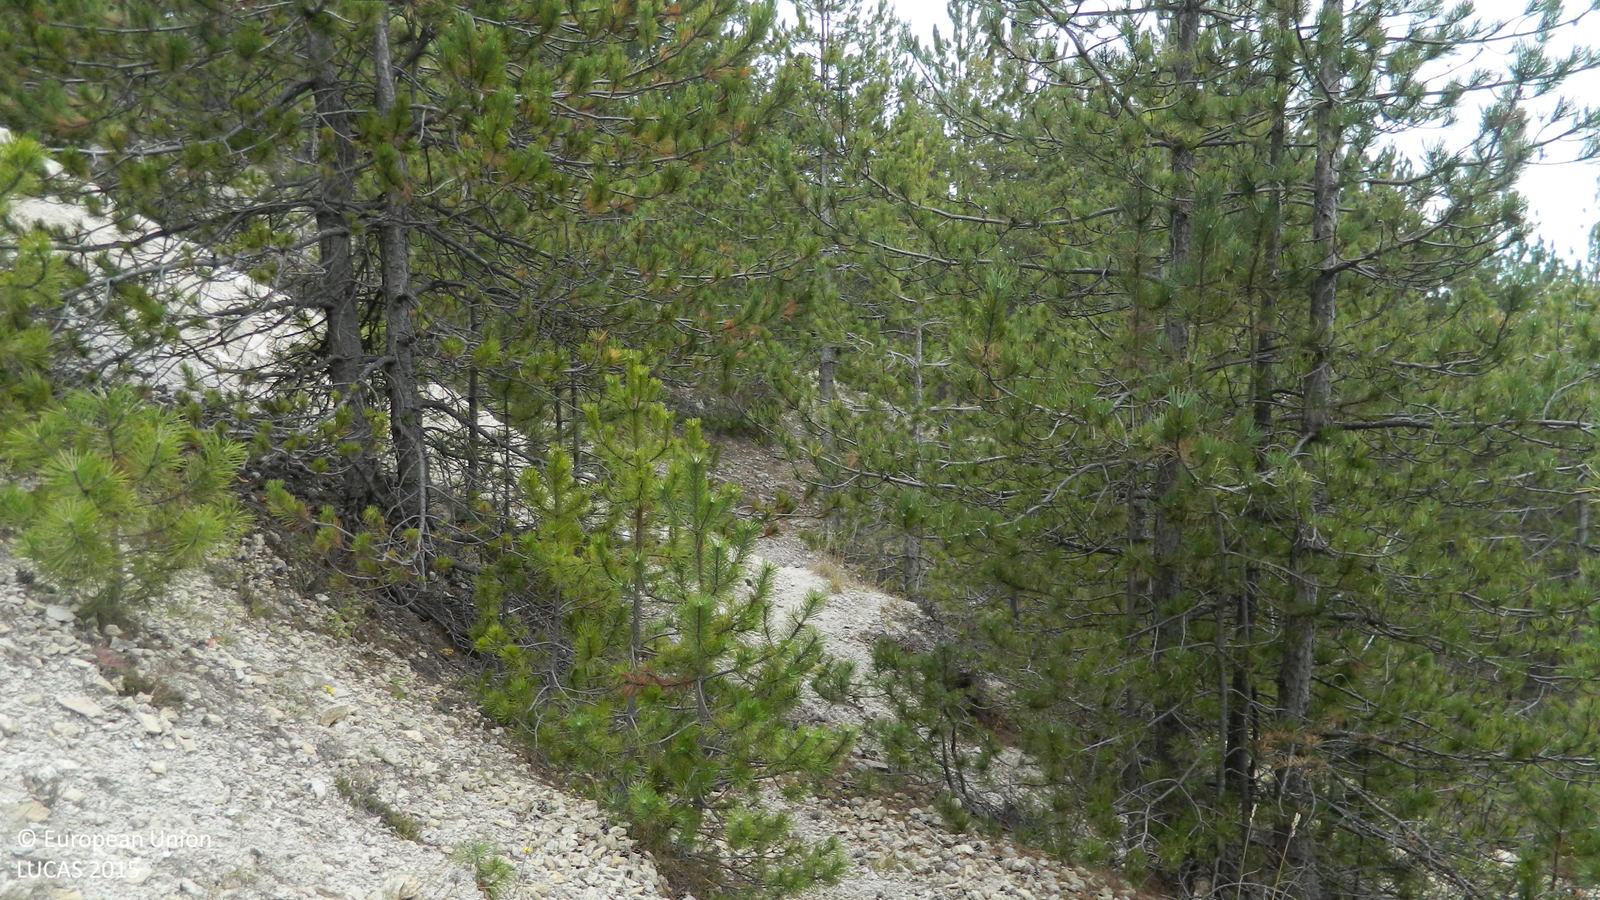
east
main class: Woodland
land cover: Pine dominated coniferous woodland
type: alpine coniferous forest
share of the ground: 50 - 75 %
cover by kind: coniferous forest trees 70 %, unconsolidated bare surface 30 %
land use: Forestry
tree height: > 5 m
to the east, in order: Pine dominated coniferous woodland; Rocks and stones; Pine dominated coniferous woodland; Grassland without tree/shrub cover; Electric lines; Grassland without tree/shrub cover; Artificial constructions in urban areas; Broadleaved woodland; Shrubland with sparse tree cover; Electric lines; Shrubland with sparse tree cover; Broadleaved woodland; Tracks; Electric lines; Shrubland with sparse tree cover; Electric lines; Shrubland with sparse tree cover; Grassland with sparse tree/shrub cover
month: November
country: BG
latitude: 41.8346
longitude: 25.0450
